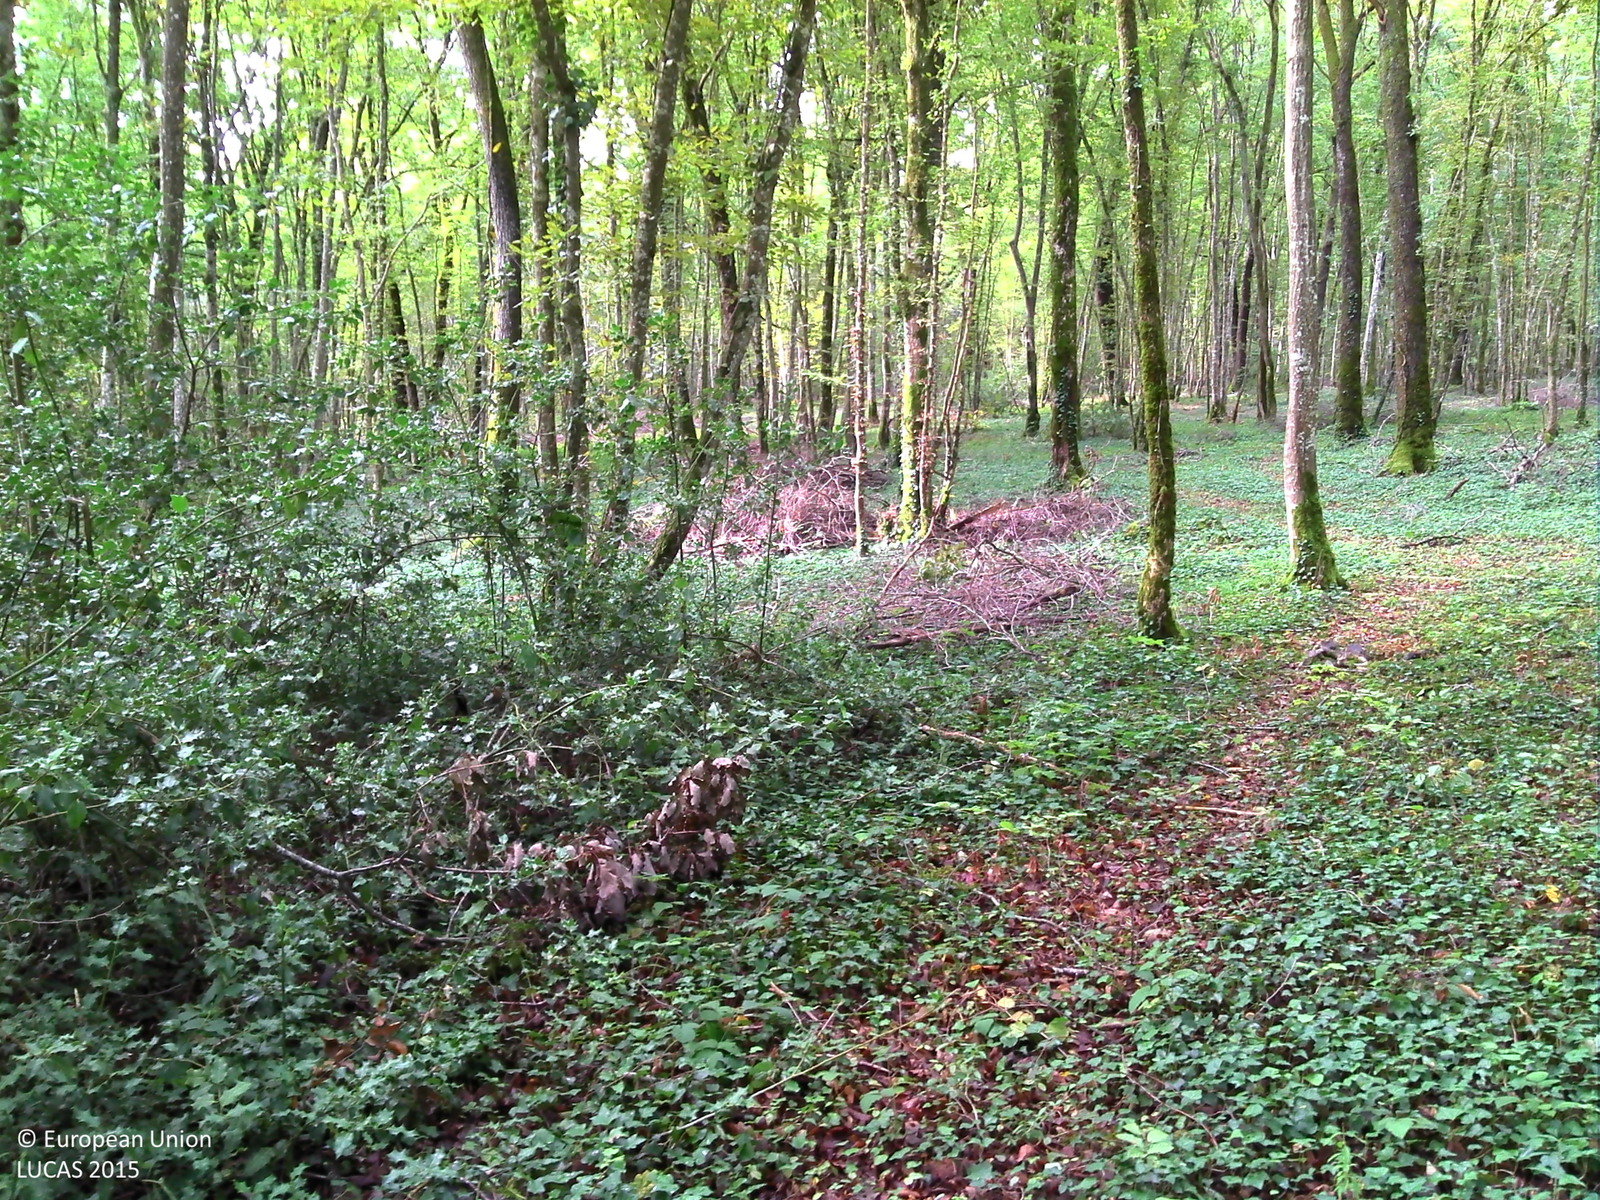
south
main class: Woodland
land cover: Broadleaved woodland
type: mesophytic deciduous forest
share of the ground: > 75 %
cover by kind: broadleaved forest trees 80 %, herbaceous plants 10 %, shrubs 5 %, lichens and mosses 5 %
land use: Forestry
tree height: > 5 m
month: September
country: FR
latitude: 48.2996
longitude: 4.8082
